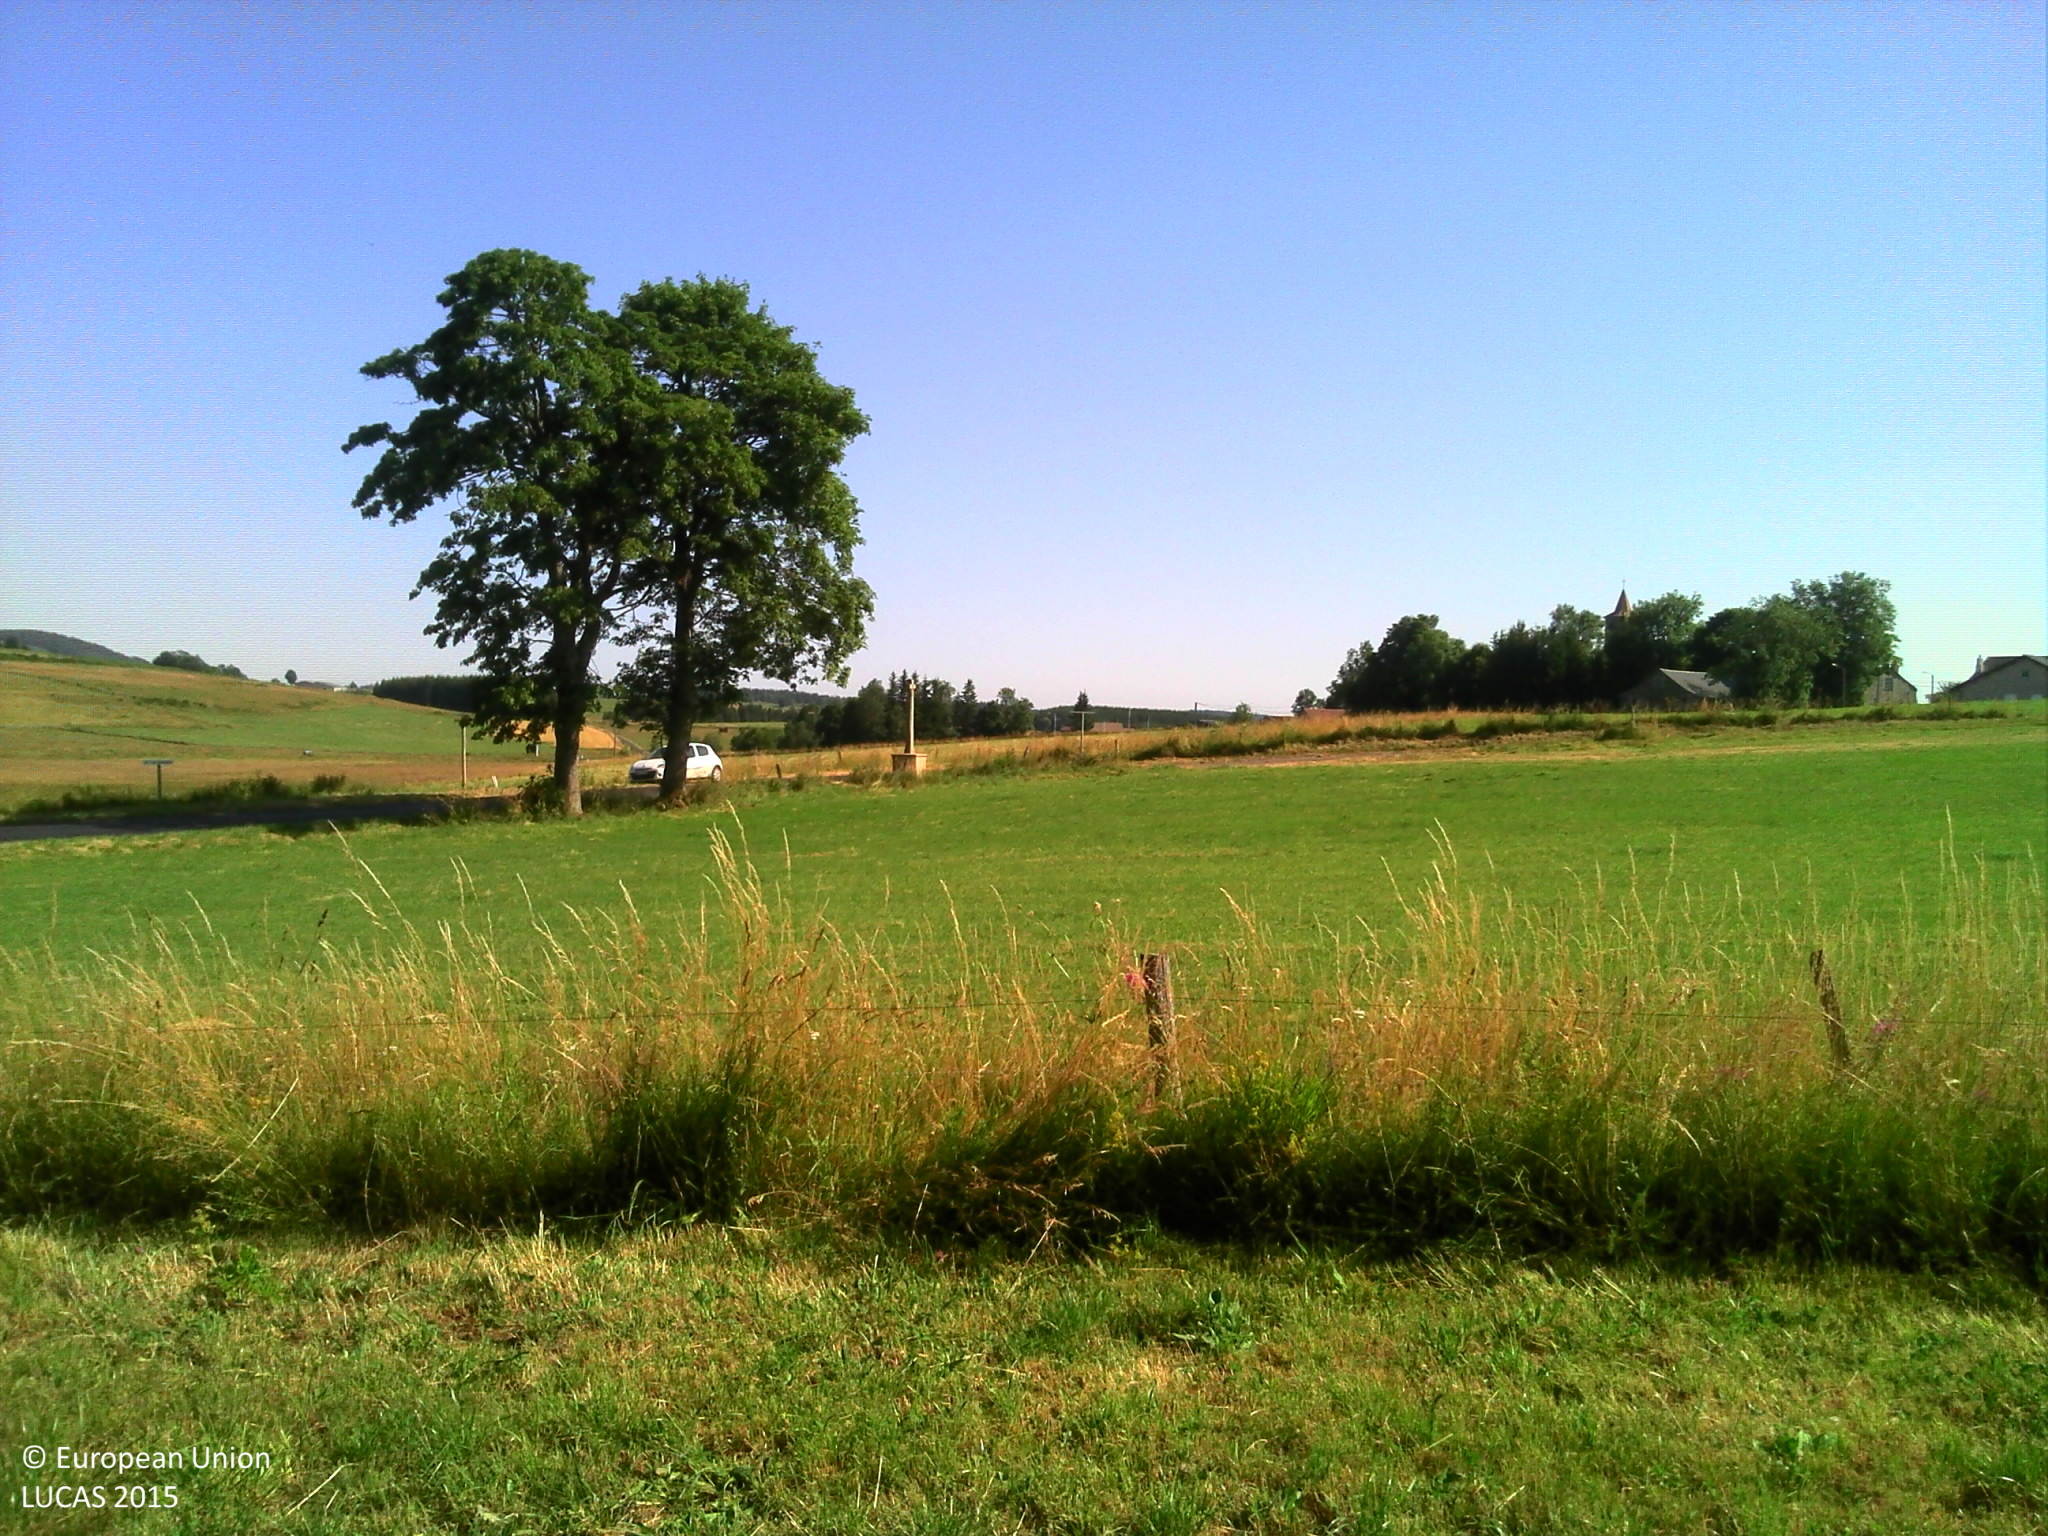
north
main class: Grassland
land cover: Grassland without tree/shrub cover
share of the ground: > 75 %
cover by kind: herbaceous plants 100 %
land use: Agriculture (excluding fallow land and kitchen gardens)
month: July
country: FR
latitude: 44.9869
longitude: 4.2595
